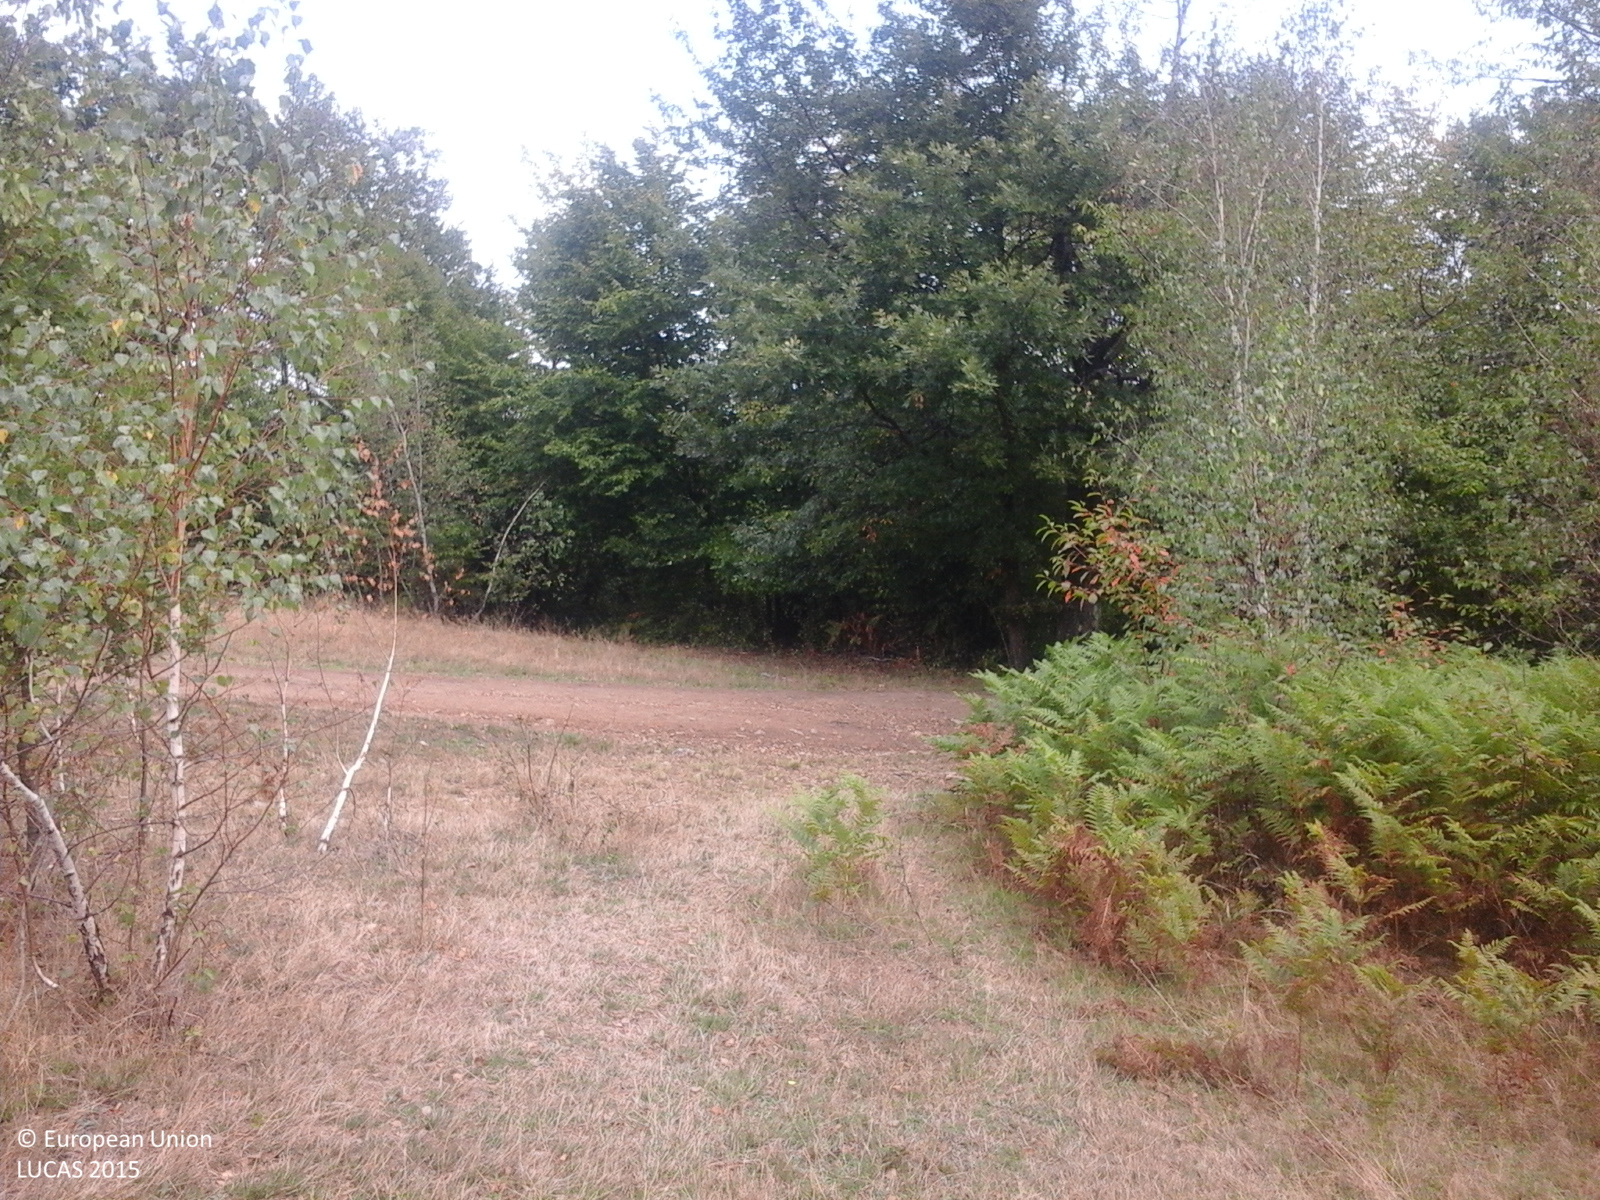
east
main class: Grassland
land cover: Grassland without tree/shrub cover
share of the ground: > 75 %
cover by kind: herbaceous plants 100 %
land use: Agriculture (excluding fallow land and kitchen gardens)
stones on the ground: < 10 %
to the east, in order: Grassland without tree/shrub cover; Broadleaved woodland; Tracks; Fences; Broadleaved woodland; Grassland with sparse tree/shrub cover; Broadleaved woodland; Grassland without tree/shrub cover; Other fruit trees and berries; Grassland without tree/shrub cover; Fences; Grassland without tree/shrub cover; Fences; Other fresh vegetables; Fences; Grassland without tree/shrub cover; Grassland with sparse tree/shrub cover
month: September
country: RO
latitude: 46.9211
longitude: 22.5429
